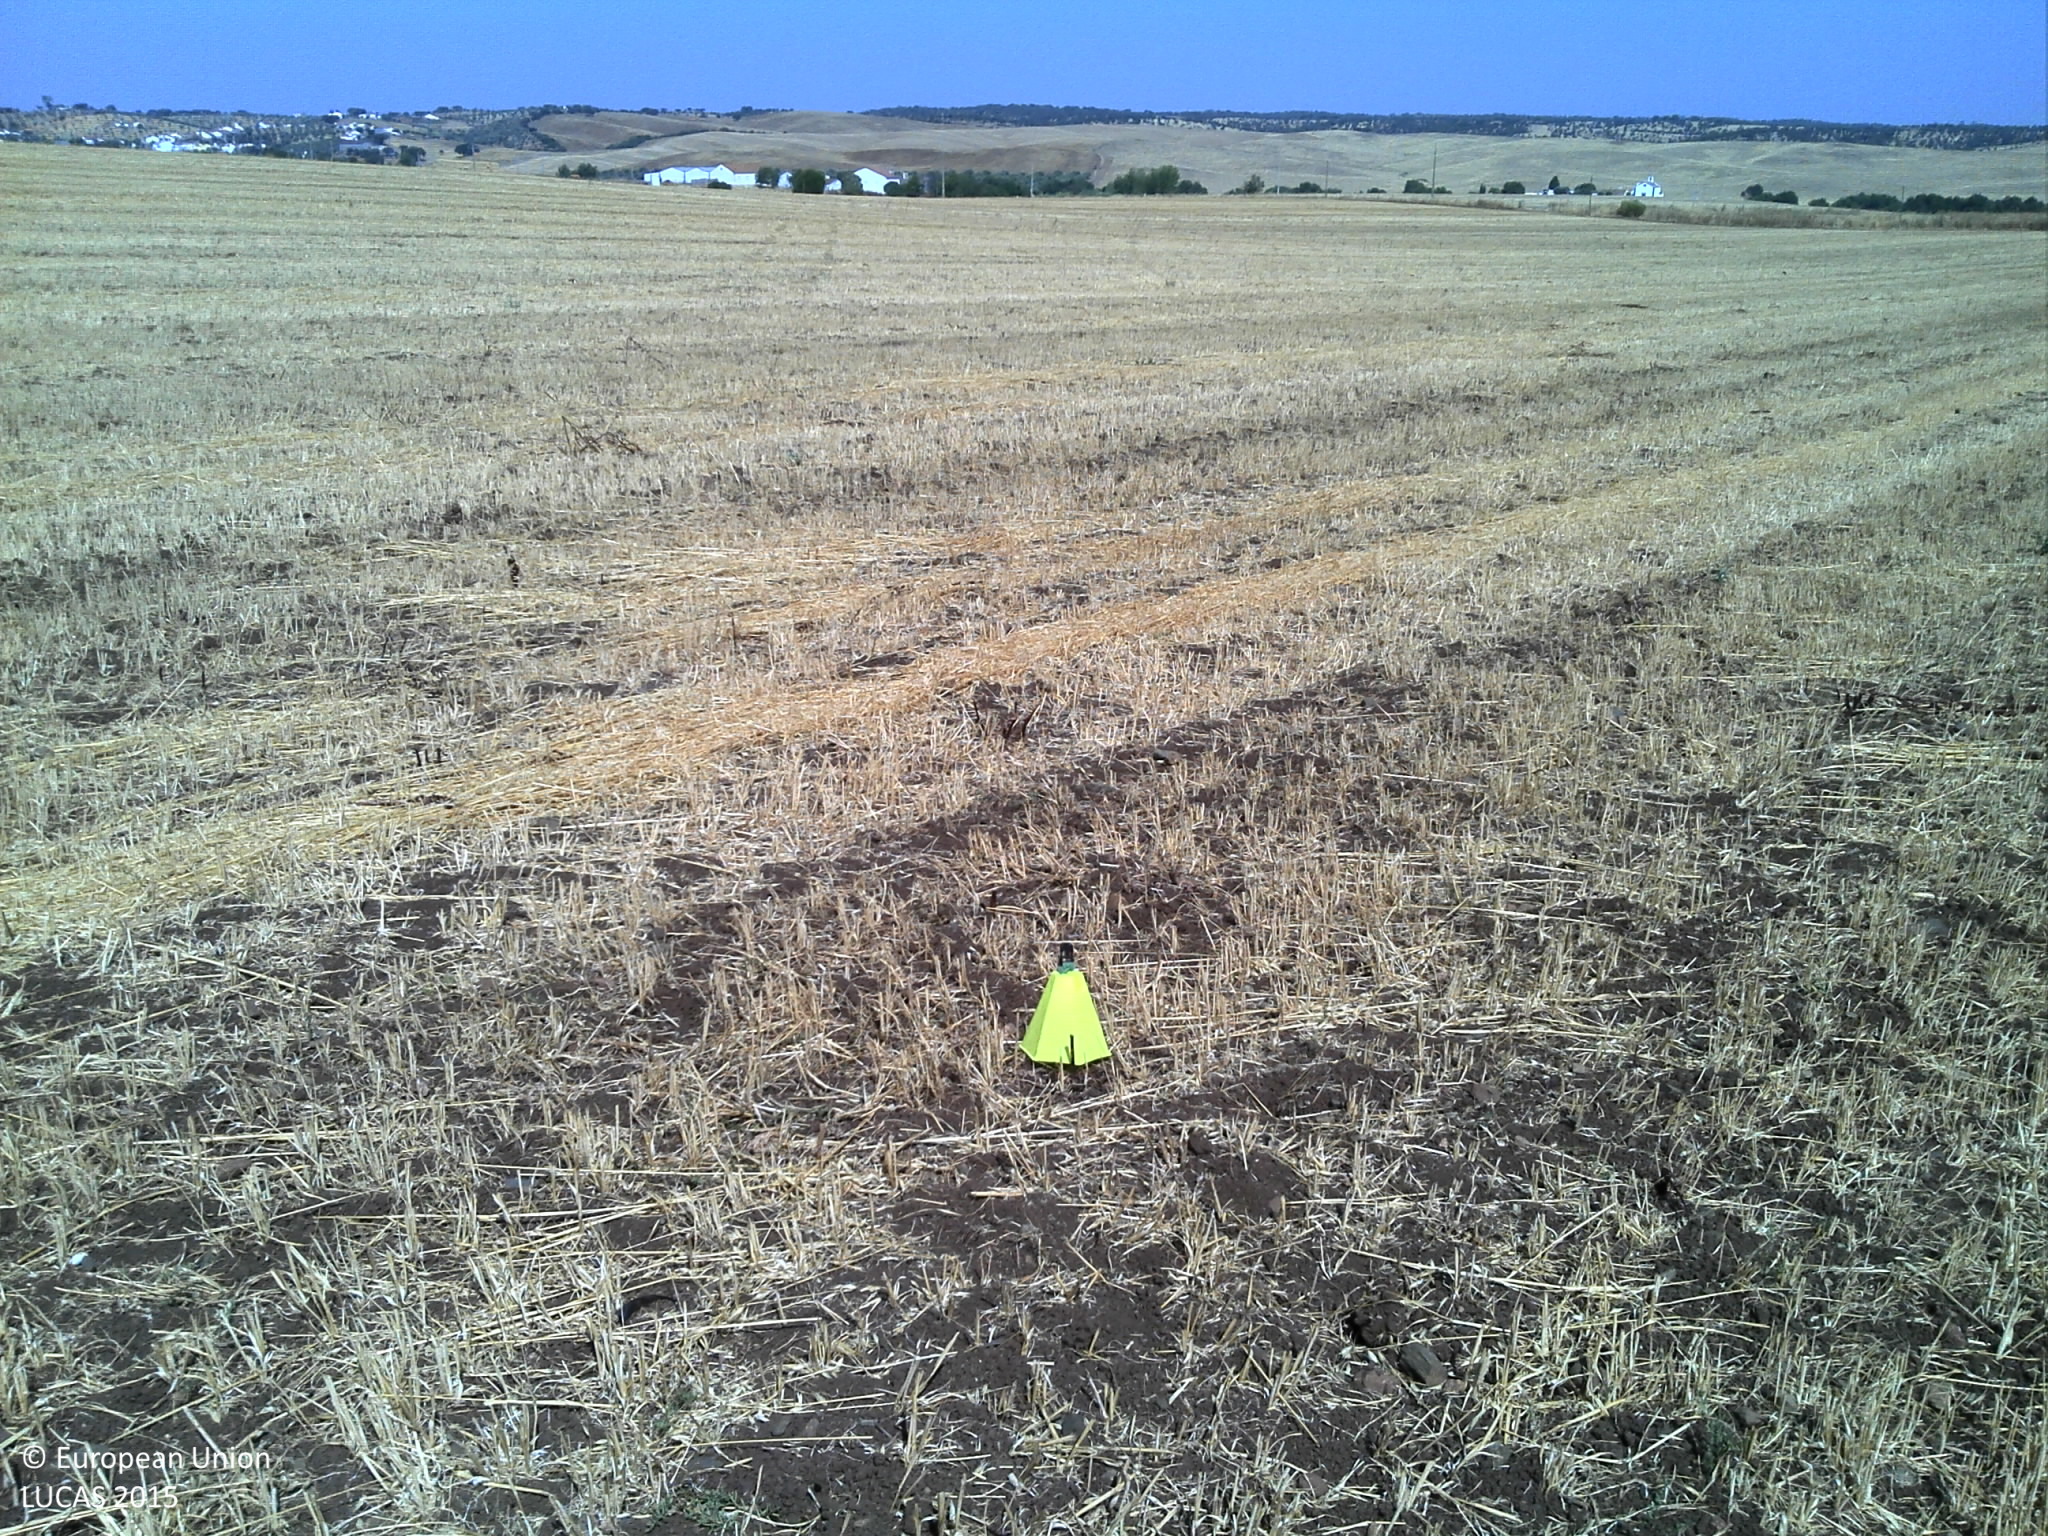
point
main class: Cropland
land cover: Oats
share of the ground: 10 - 25 %
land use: Agriculture (excluding fallow land and kitchen gardens)
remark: Harvested field
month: July
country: PT
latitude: 38.5740
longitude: -7.6759
